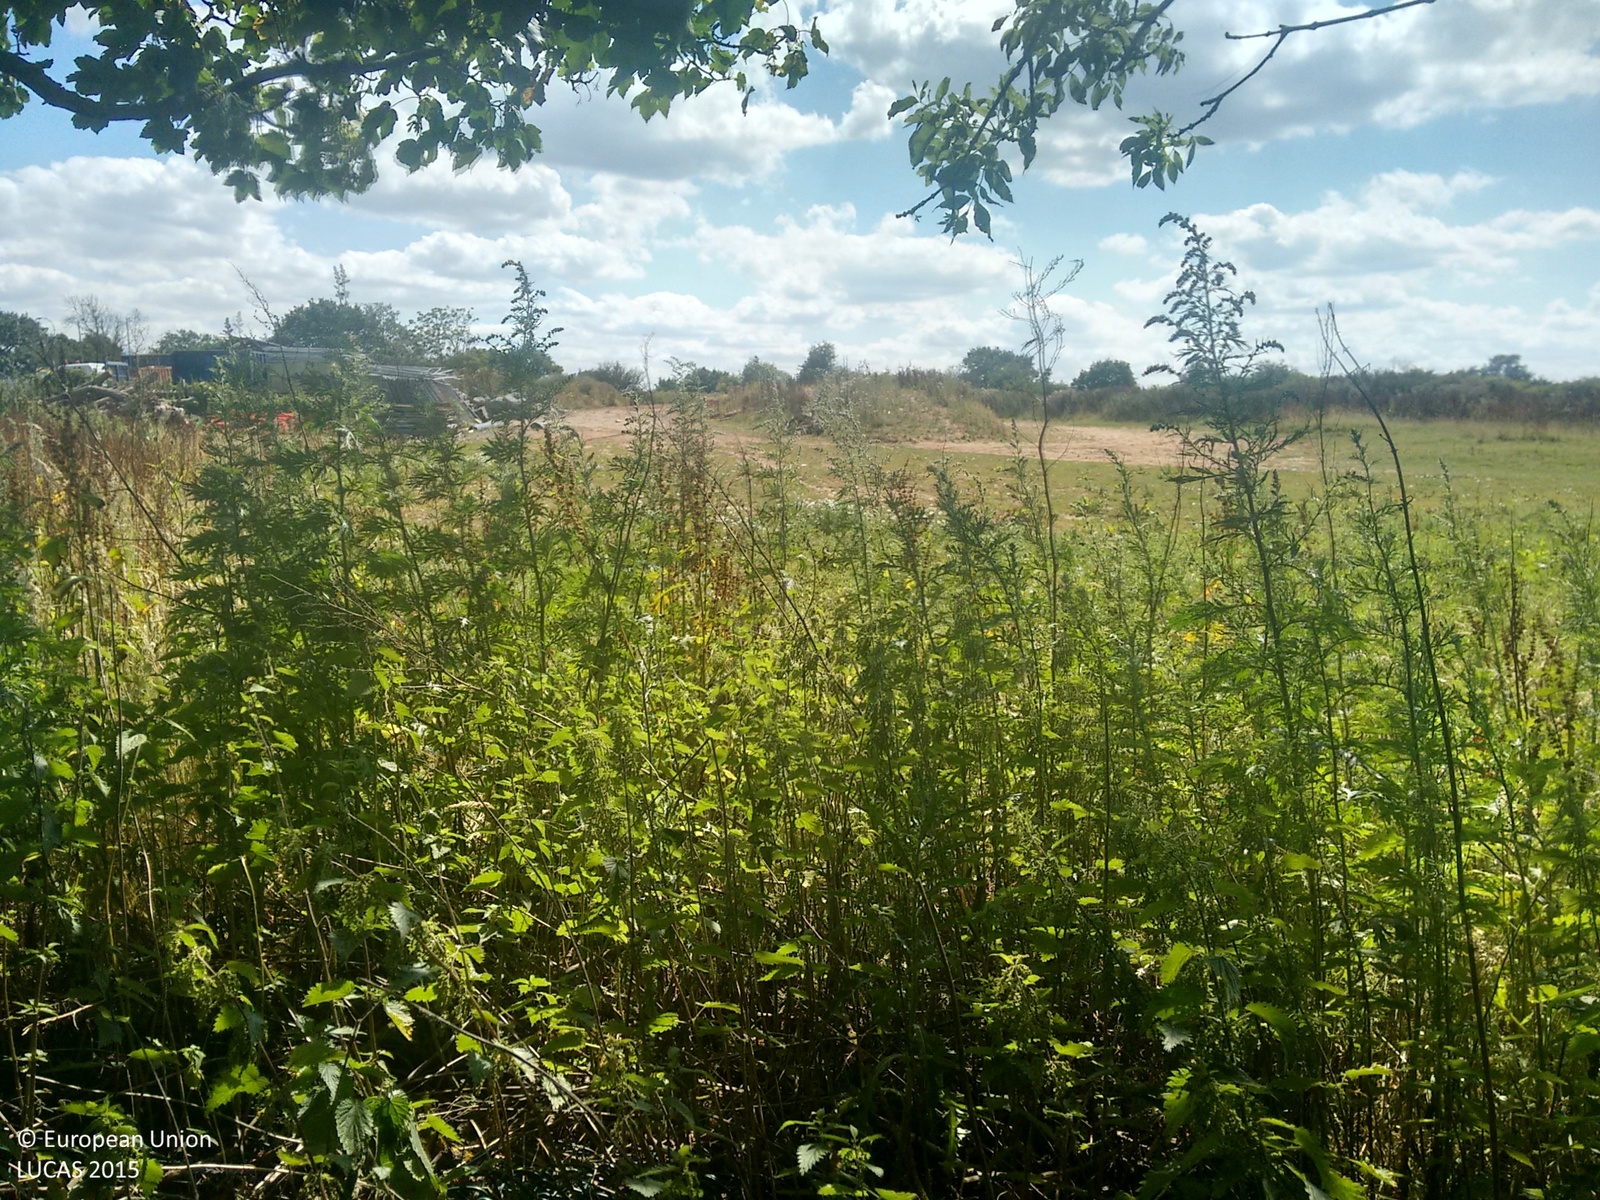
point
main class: Grassland
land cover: Grassland without tree/shrub cover
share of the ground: > 75 %
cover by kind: herbaceous plants 100 %
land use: Semi-natural and natural areas not in use
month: July
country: GB
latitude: 52.4457
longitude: -1.7511
